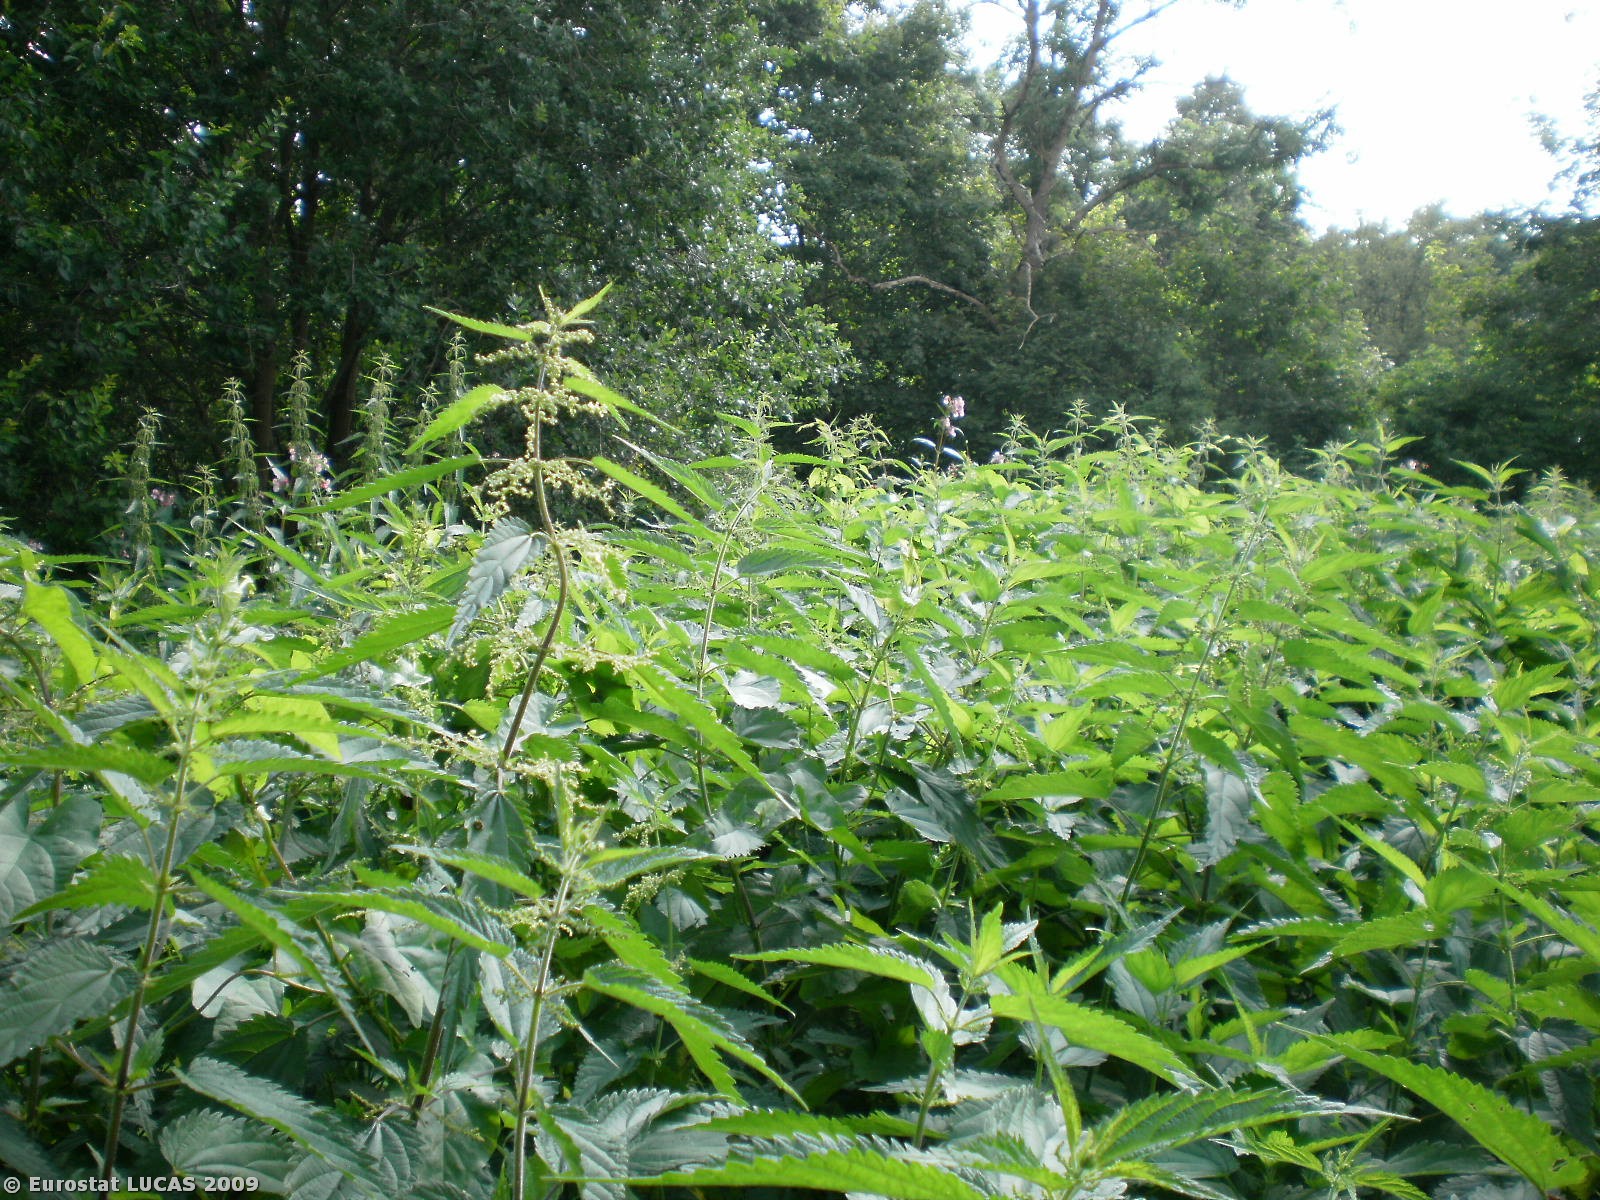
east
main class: Grassland
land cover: Spontaneously vegetated surfaces
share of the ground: > 75 %
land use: Unused
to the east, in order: Spontaneously vegetated surfaces; Rivers and streams; Broadleaved woodland; Grass margins; Paved roads, cycling and walking lanes; Grass margins; Abandoned hedges; Electric lines; Grassland with sparse tree/shrub cover; Shrubland with sparse tree cover; Spontaneously vegetated surfaces
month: July
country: PL
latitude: 53.9184
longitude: 19.9118
